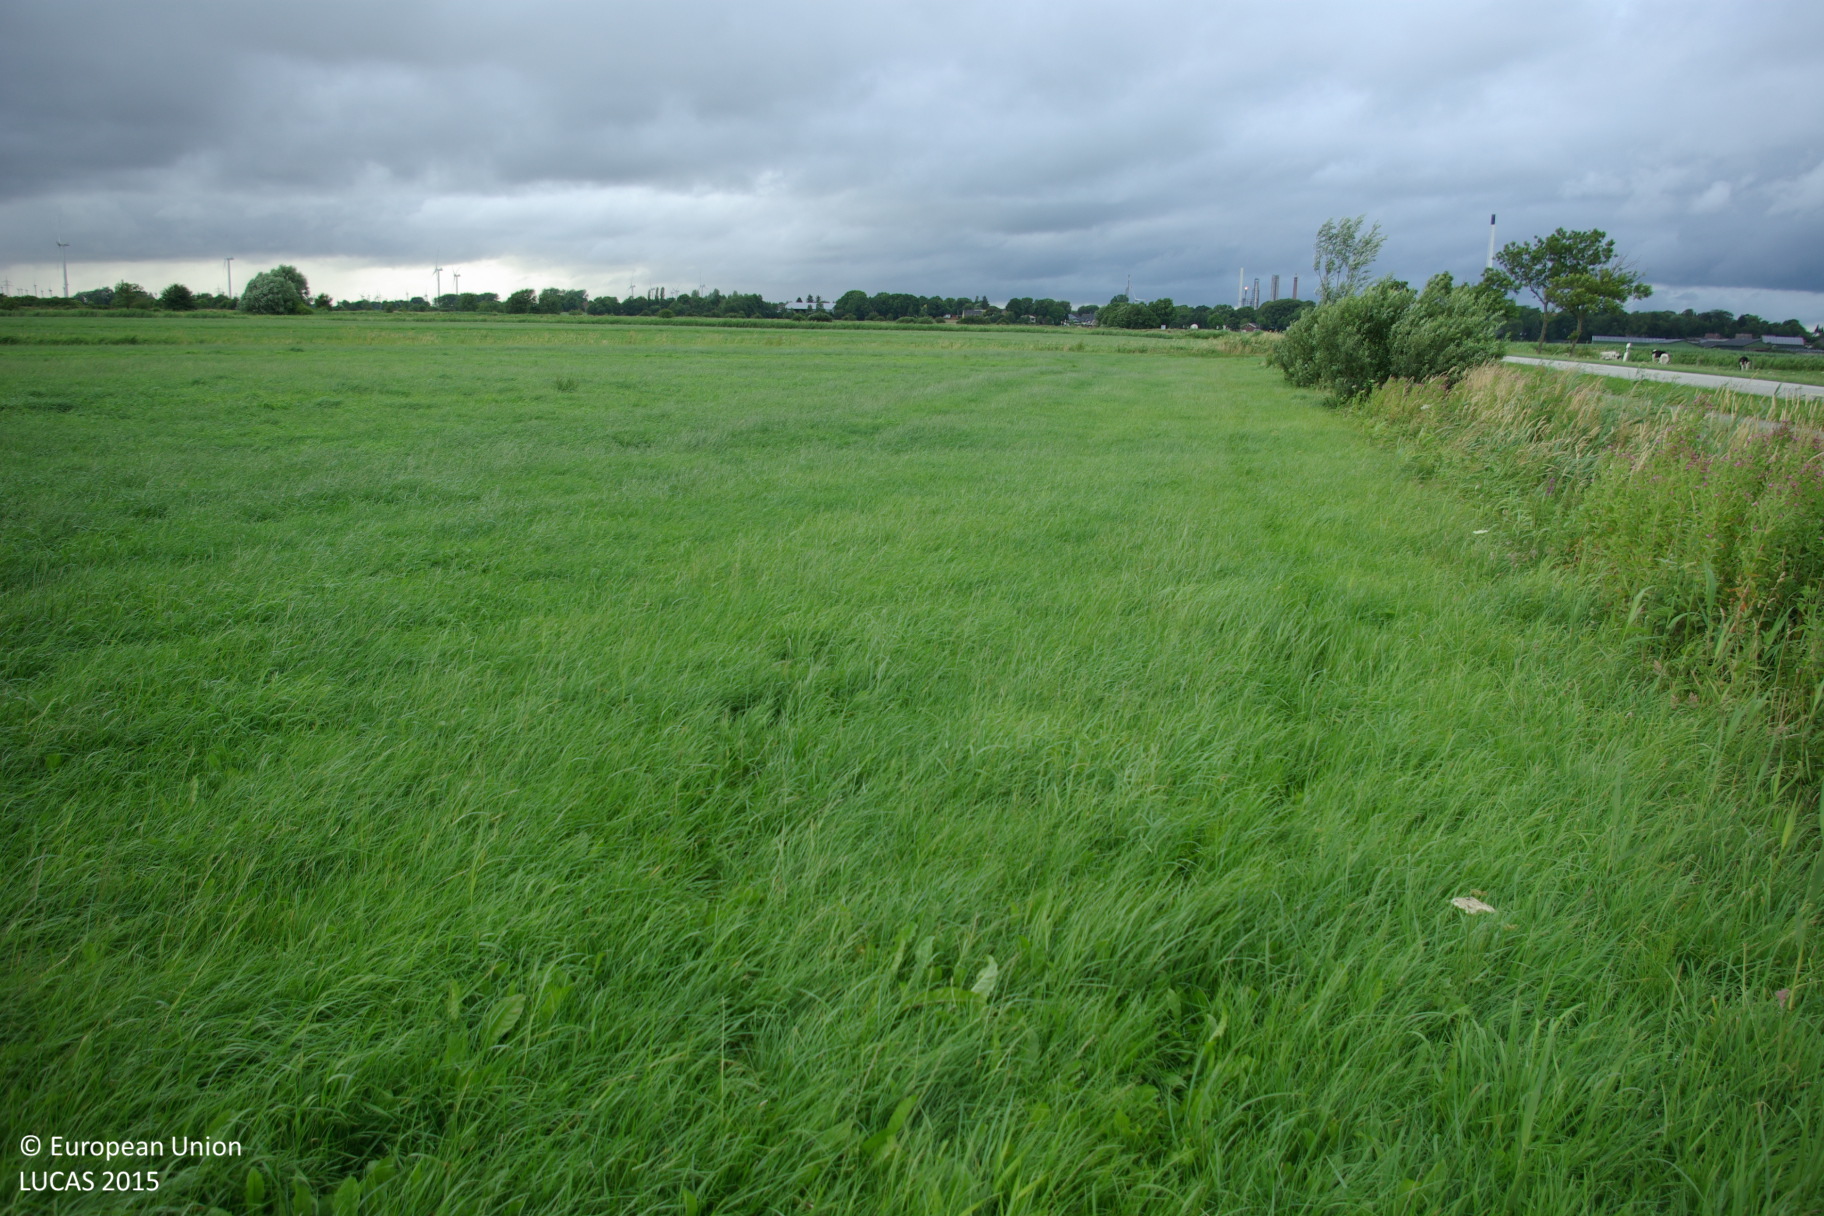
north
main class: Grassland
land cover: Grassland without tree/shrub cover
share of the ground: > 75 %
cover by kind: herbaceous plants 100 %
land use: Agriculture (excluding fallow land and kitchen gardens)
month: July
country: DE
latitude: 54.1352
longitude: 9.0669
